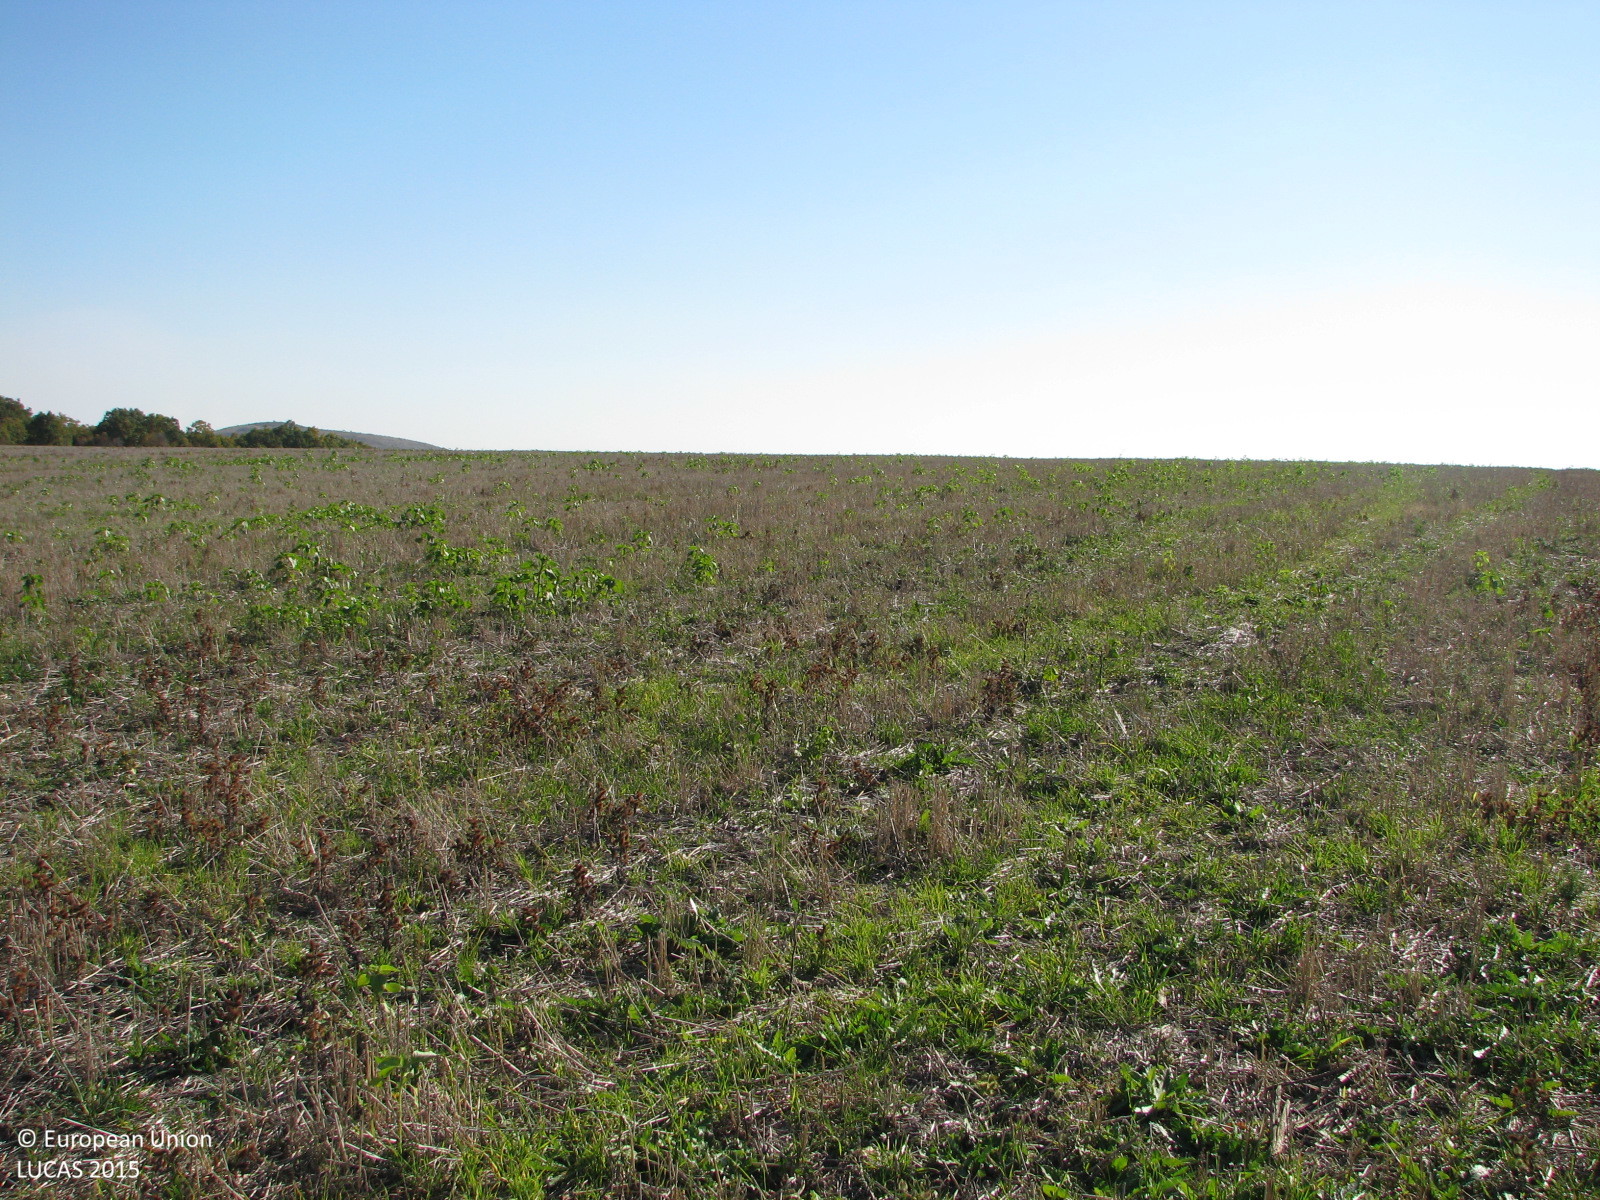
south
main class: Cropland
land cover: Common wheat
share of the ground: 25 - 50 %
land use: Agriculture (excluding fallow land and kitchen gardens)
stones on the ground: < 10 %
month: November
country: BG
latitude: 41.8675
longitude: 26.4559
